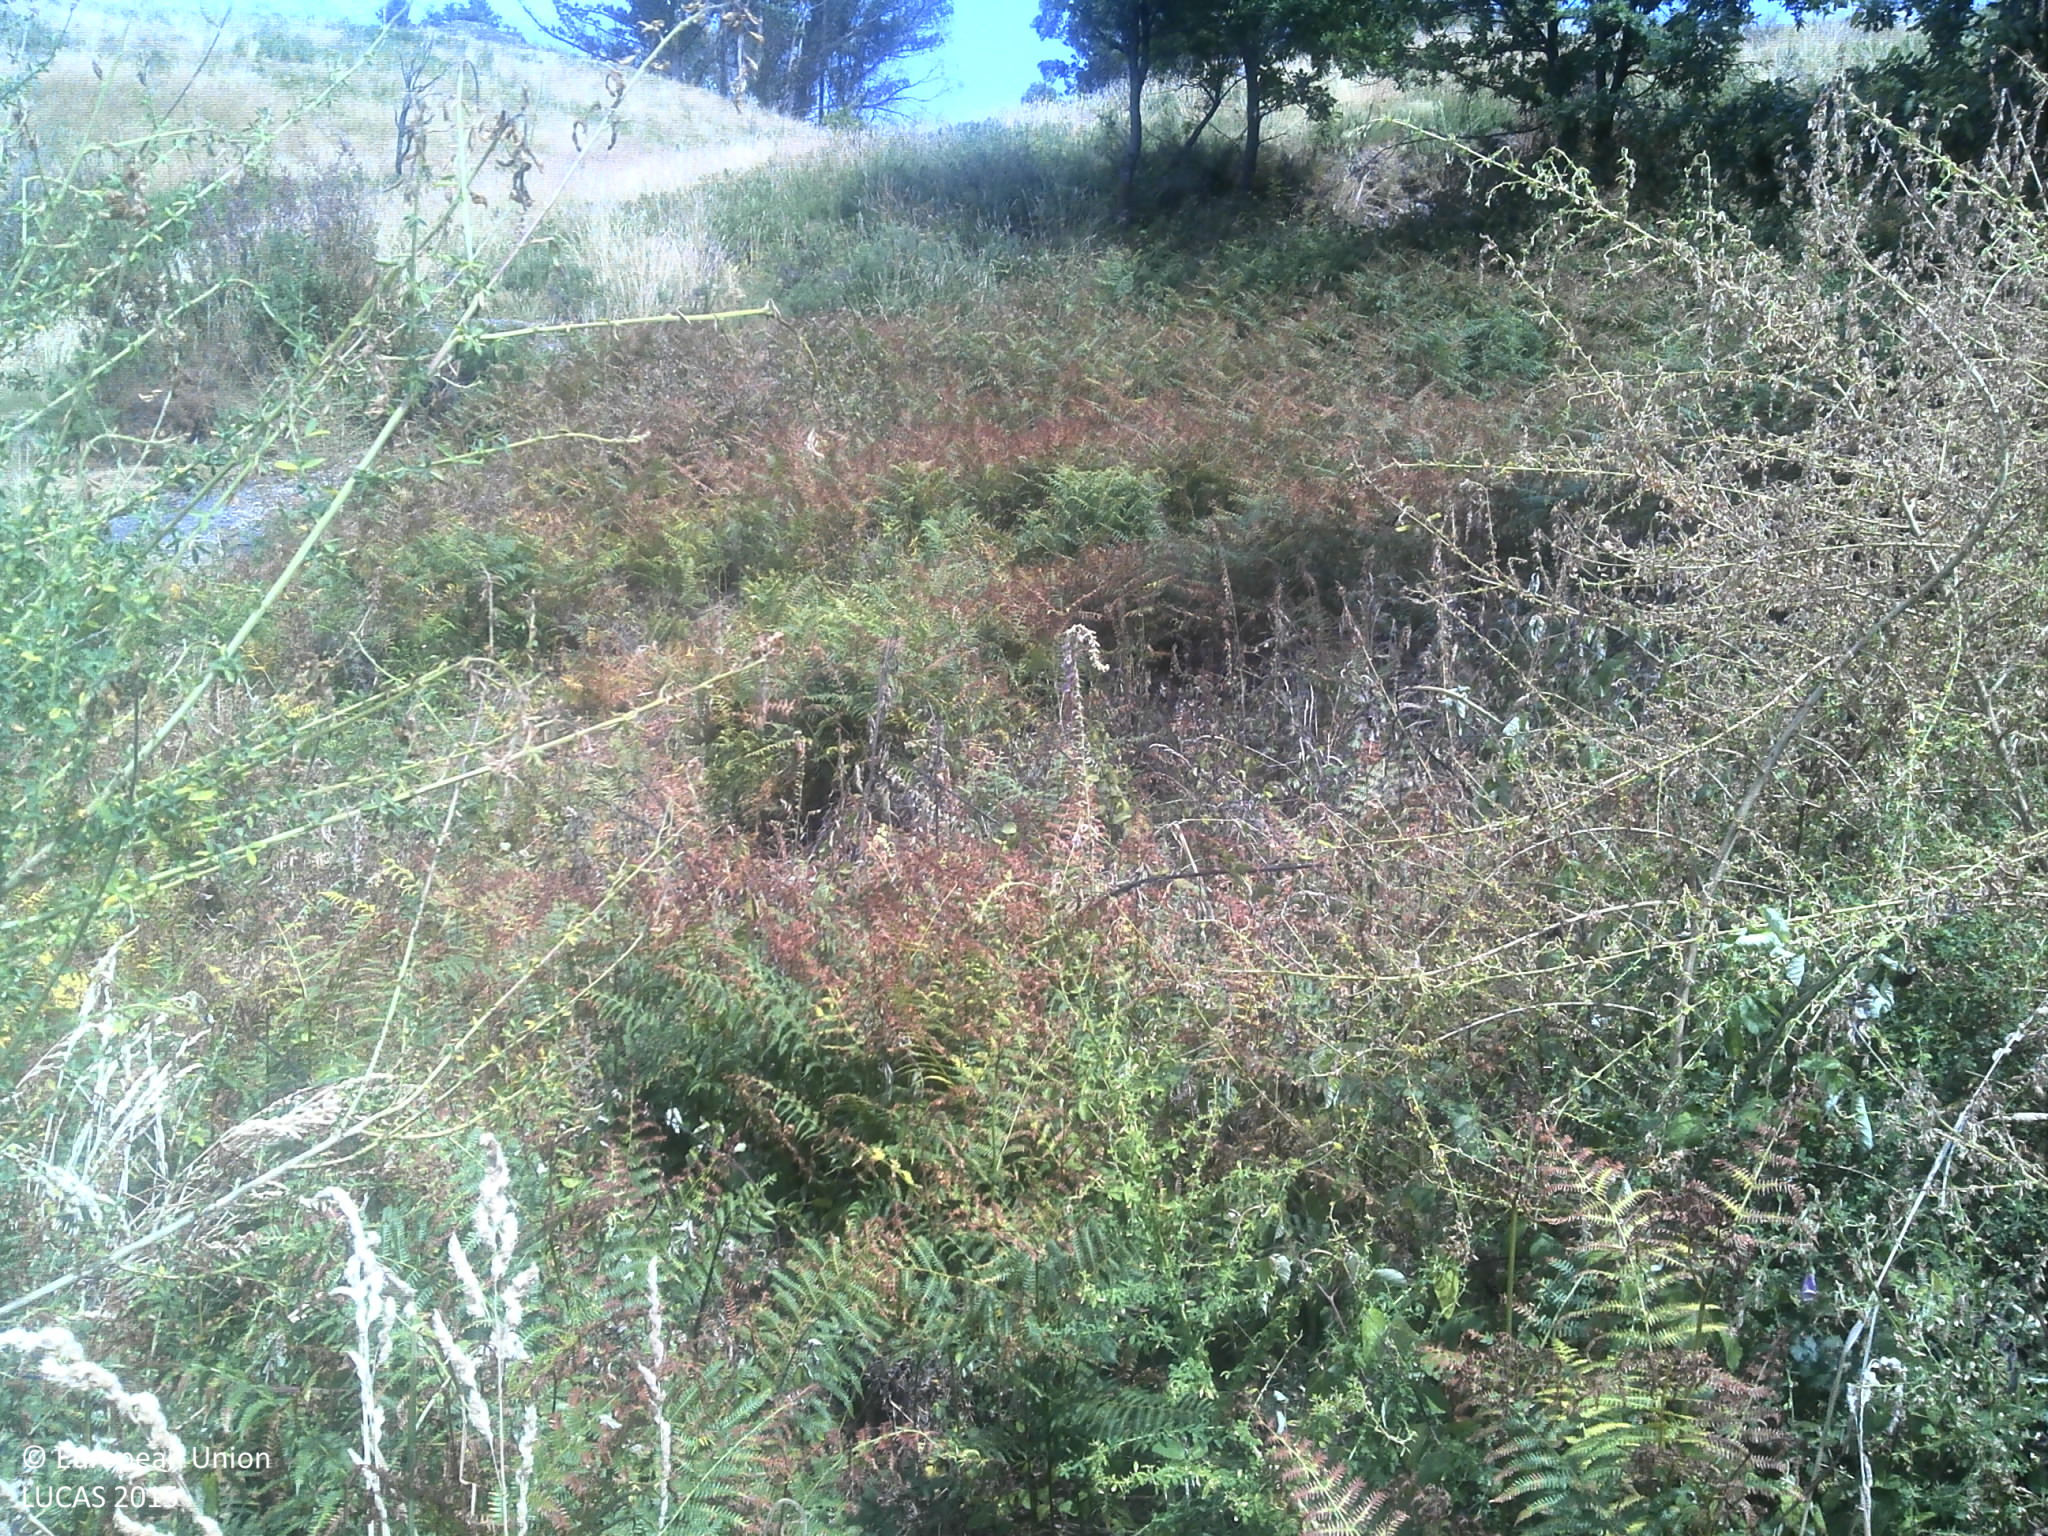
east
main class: Shrubland
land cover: Shrubland with sparse tree cover
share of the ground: > 75 %
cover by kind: shrubs 80 %, herbaceous plants 10 %, broadleaved forest trees 5 %, unconsolidated bare surface 5 %
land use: Semi-natural and natural areas not in use
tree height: > 5 m
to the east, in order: Shrubland with sparse tree cover; Shrubland without tree cover; Rock outcrops; Shrubland without tree cover; Shrubland with sparse tree cover; Shrubland without tree cover; Electric lines; Tracks; Artificial constructions in urban areas; Shrubland without tree cover; Shrubland with sparse tree cover
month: June
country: PT
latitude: 41.6365
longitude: -8.1915
